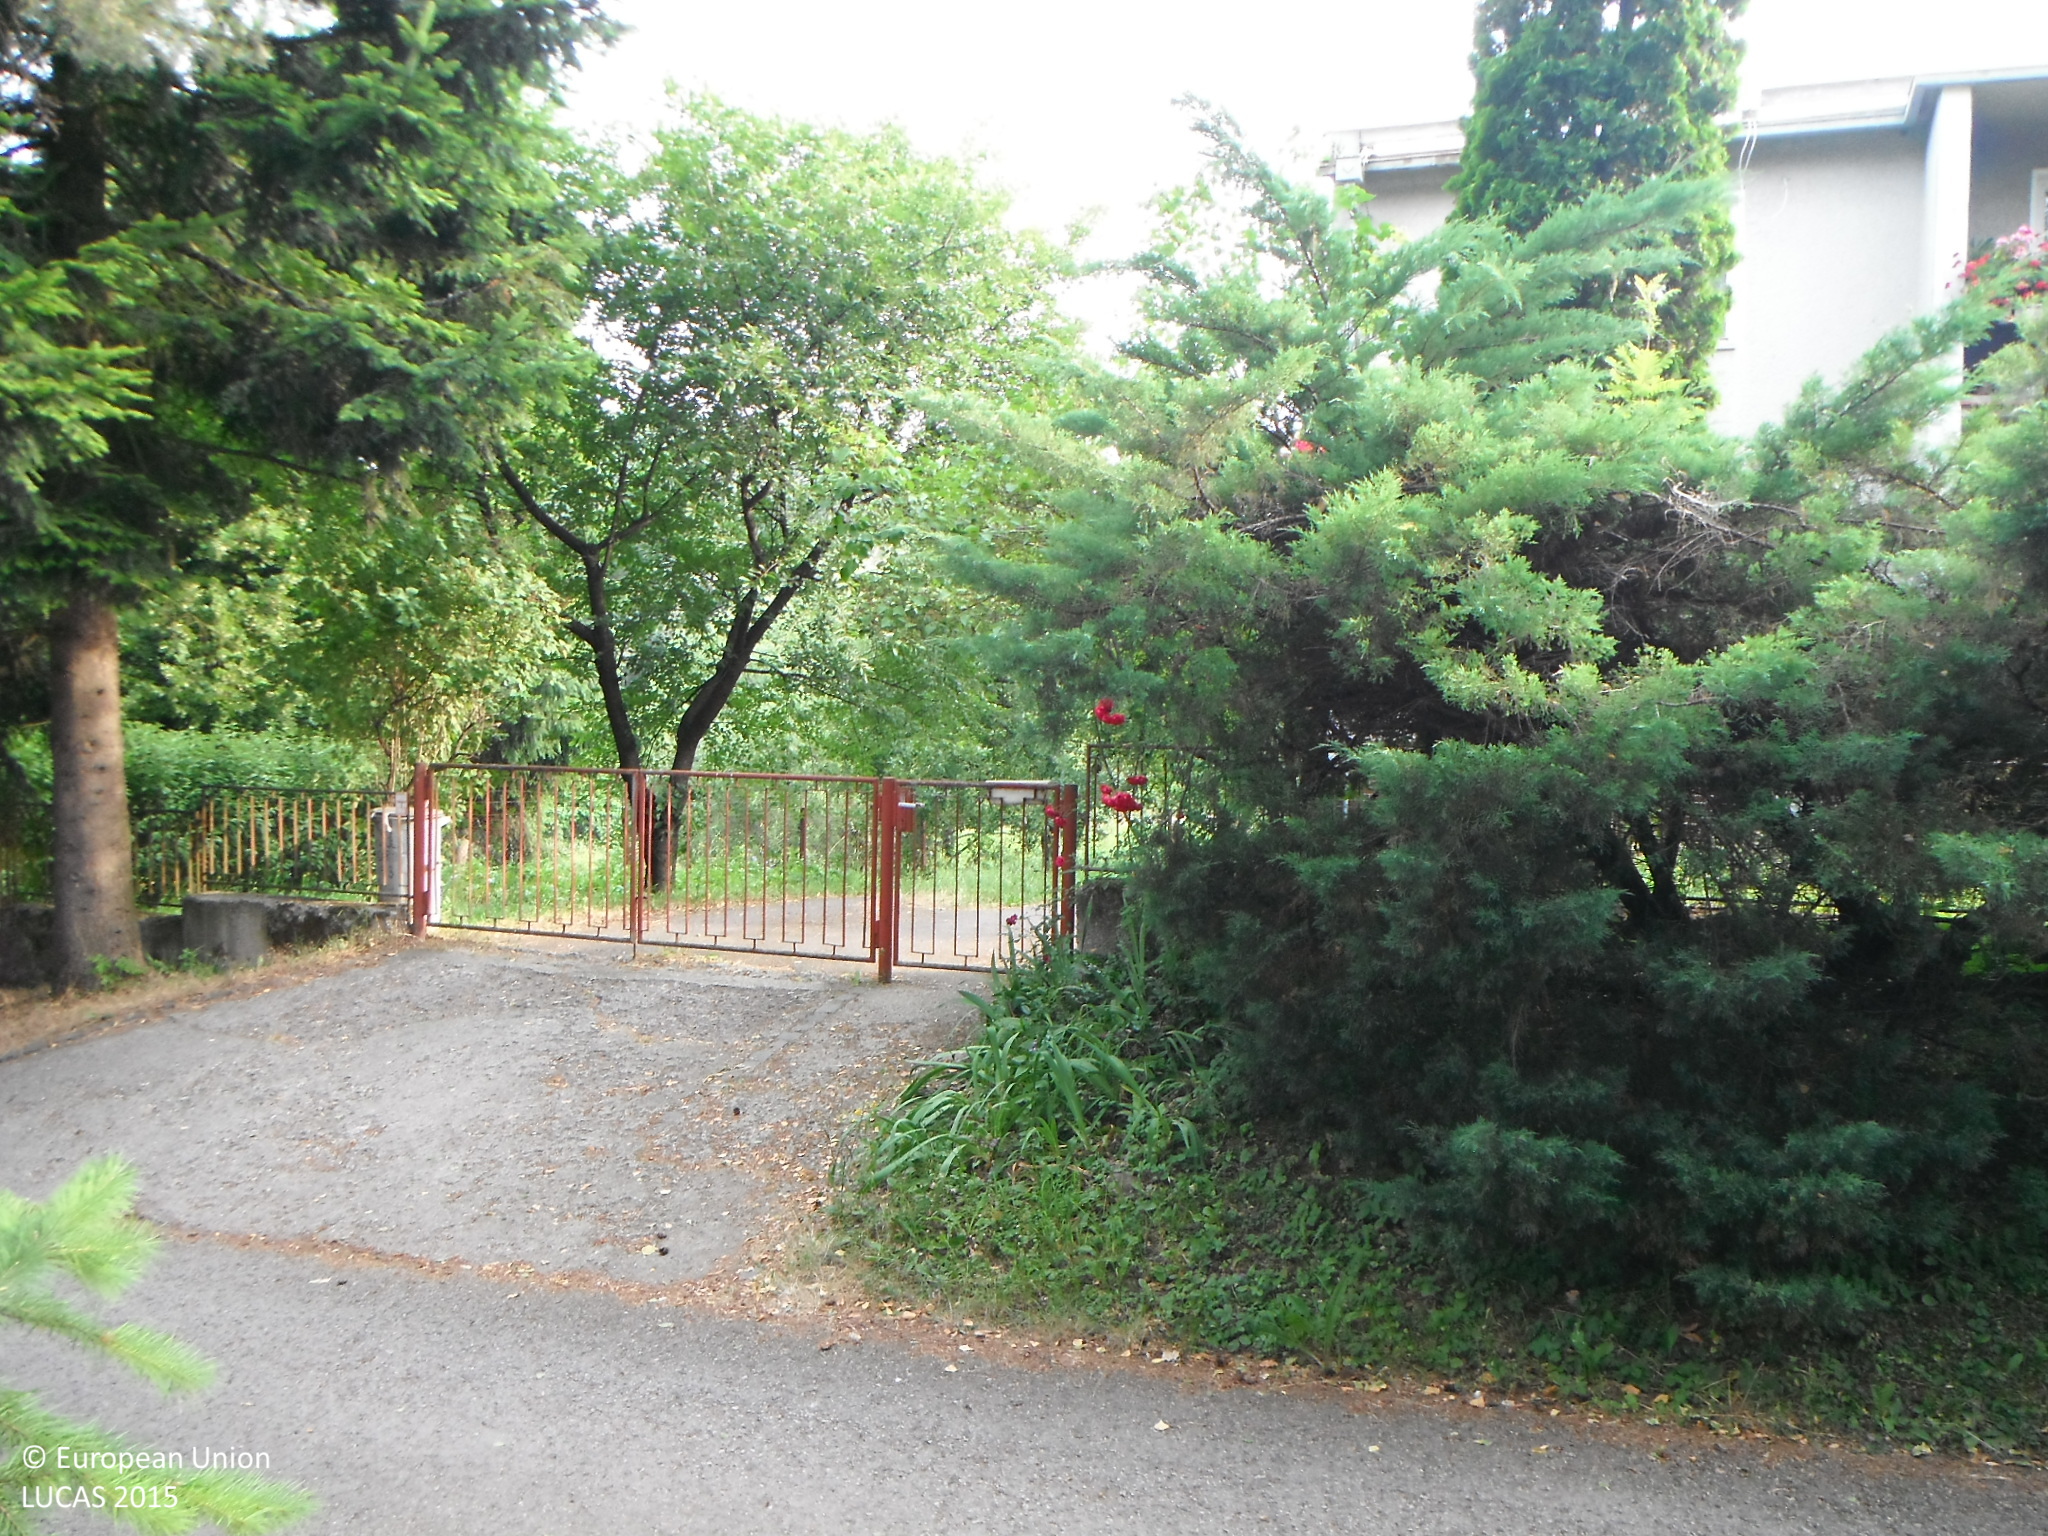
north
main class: Woodland
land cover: Other mixed woodland
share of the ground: > 75 %
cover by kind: coniferous forest trees 50 %, broadleaved forest trees 50 %
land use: Residential
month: July
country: SK
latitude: 48.5695
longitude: 19.1152
